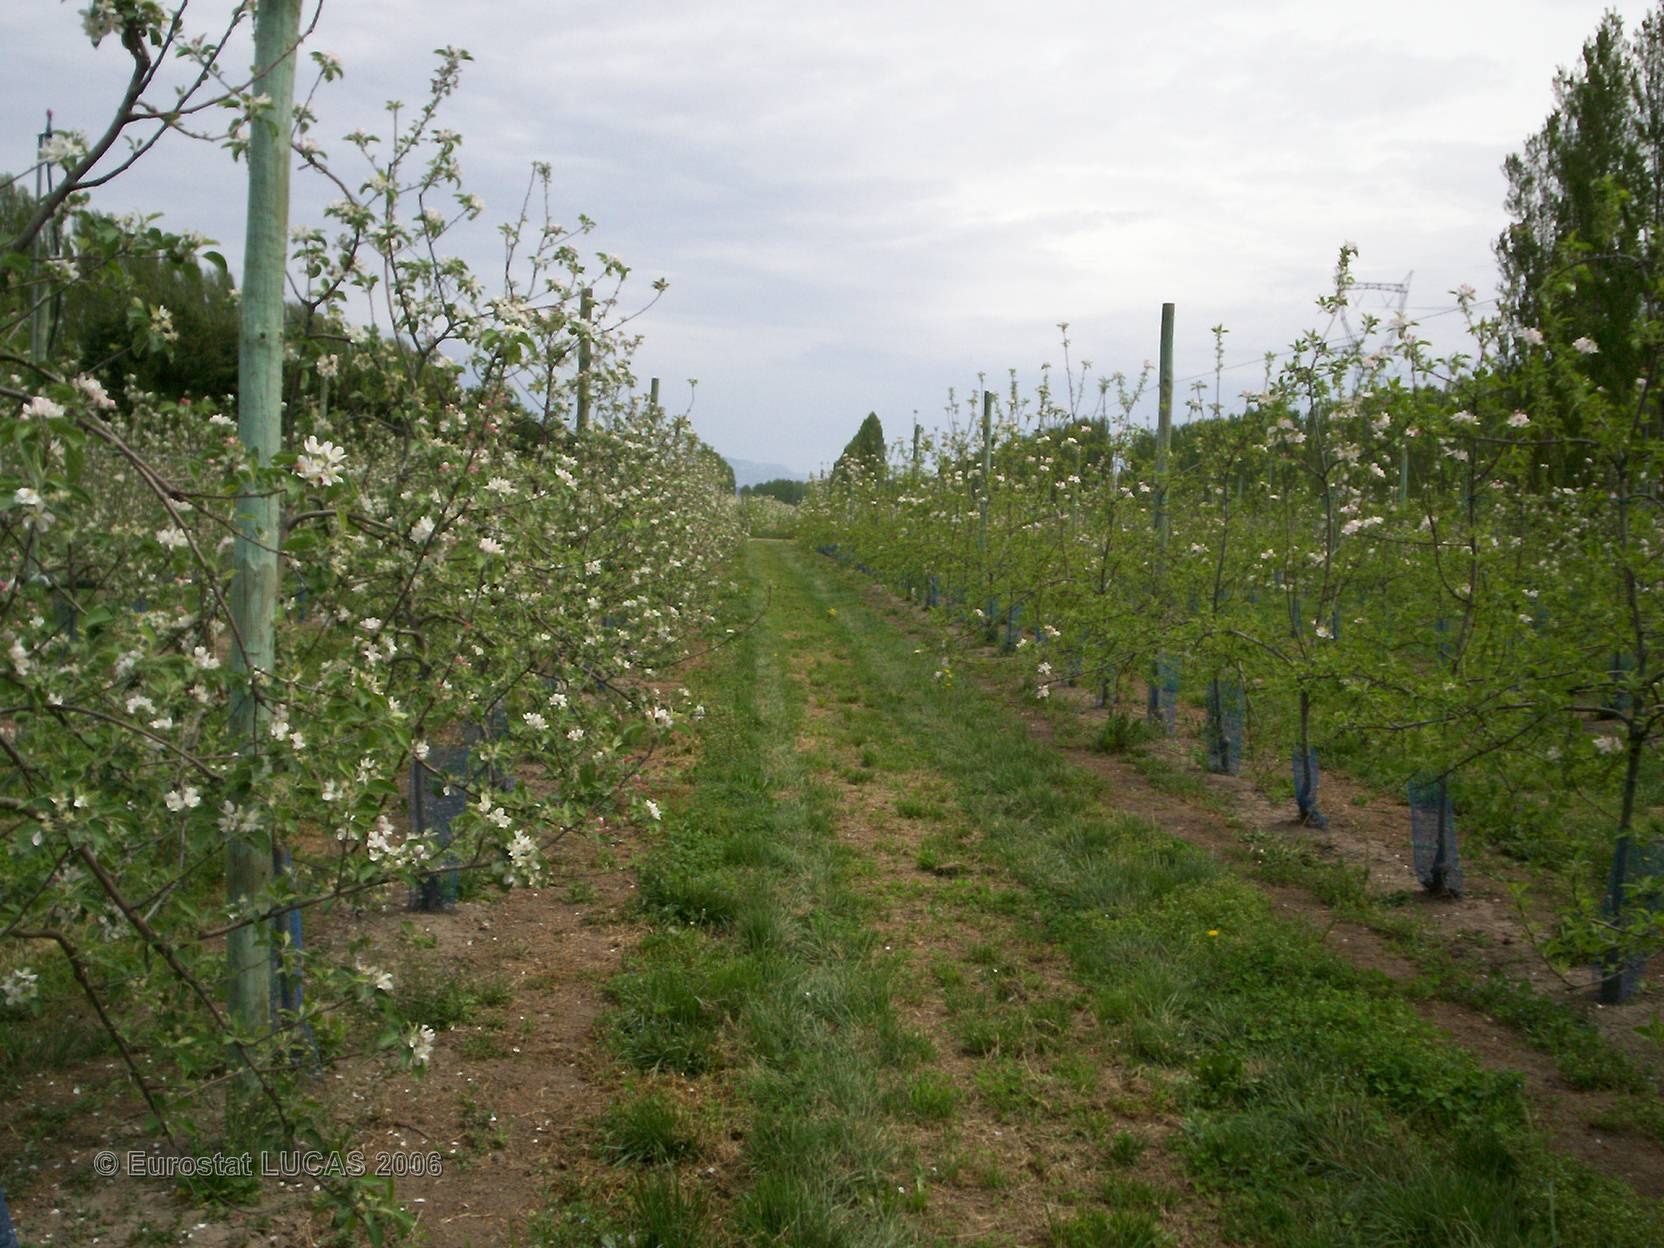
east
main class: Cropland
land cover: Apple fruit
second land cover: Grassland with sparse tree/shrub cover
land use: Agriculture (excluding fallow land and kitchen gardens)
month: April
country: FR
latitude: 43.7927
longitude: 4.9261
